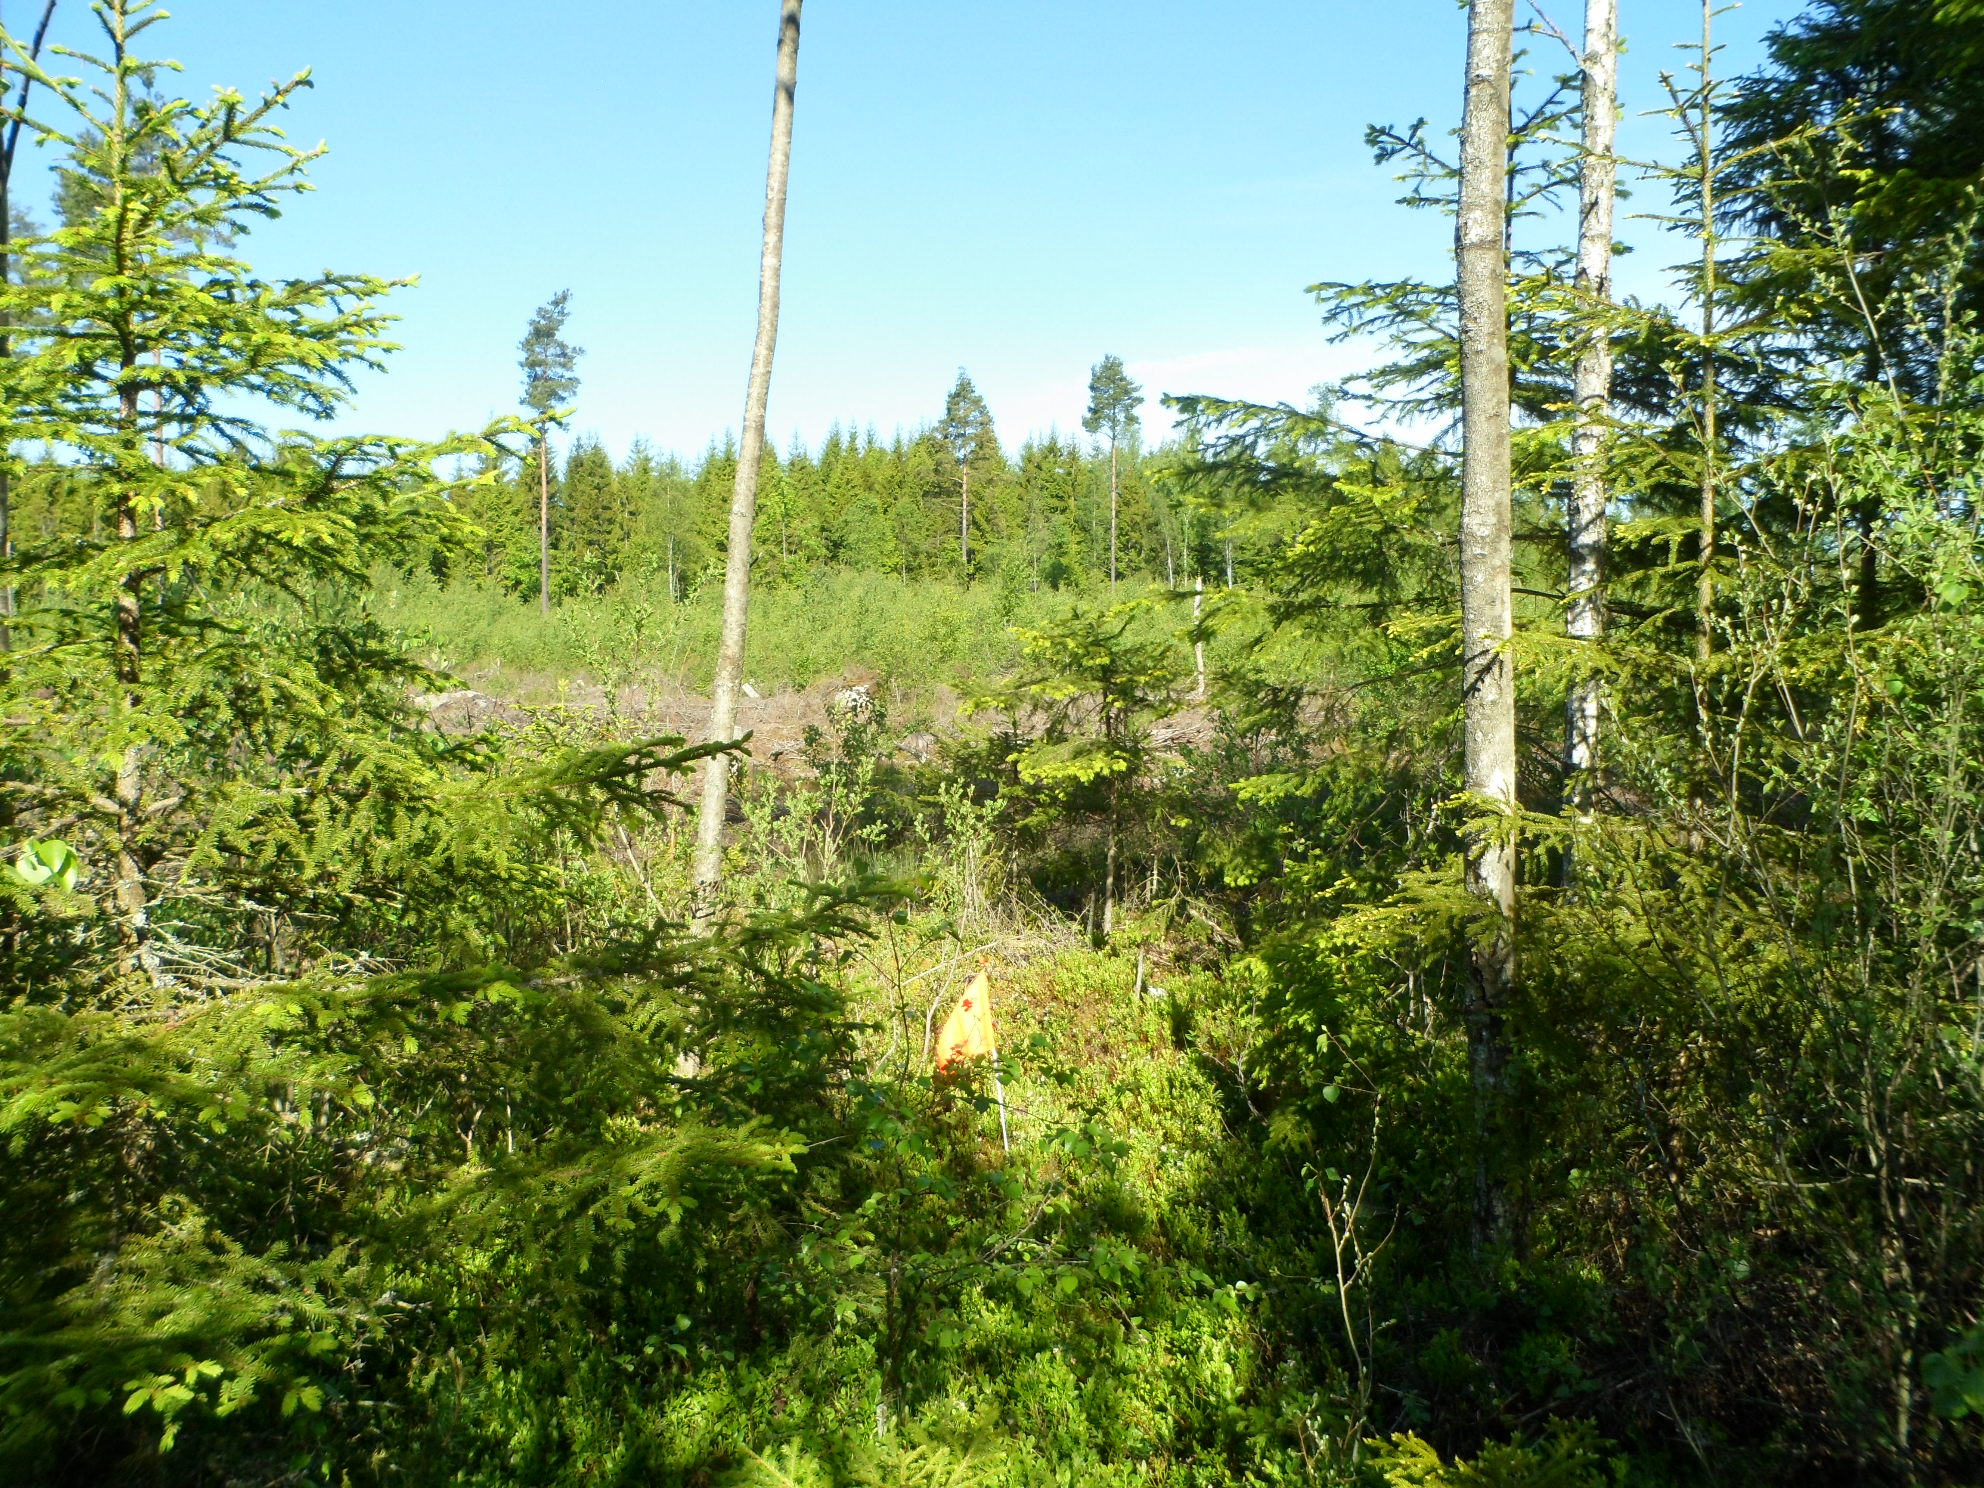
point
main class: Woodland
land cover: Spruce dominated mixed woodland
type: boreal forest
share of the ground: 50 - 75 %
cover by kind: coniferous forest trees 30 %, broadleaved forest trees 30 %, shrubs 25 %, lichens and mosses 10 %, herbaceous plants 5 %
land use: Forestry
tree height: > 5 m
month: June
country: SE
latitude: 56.8879
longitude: 14.8720
